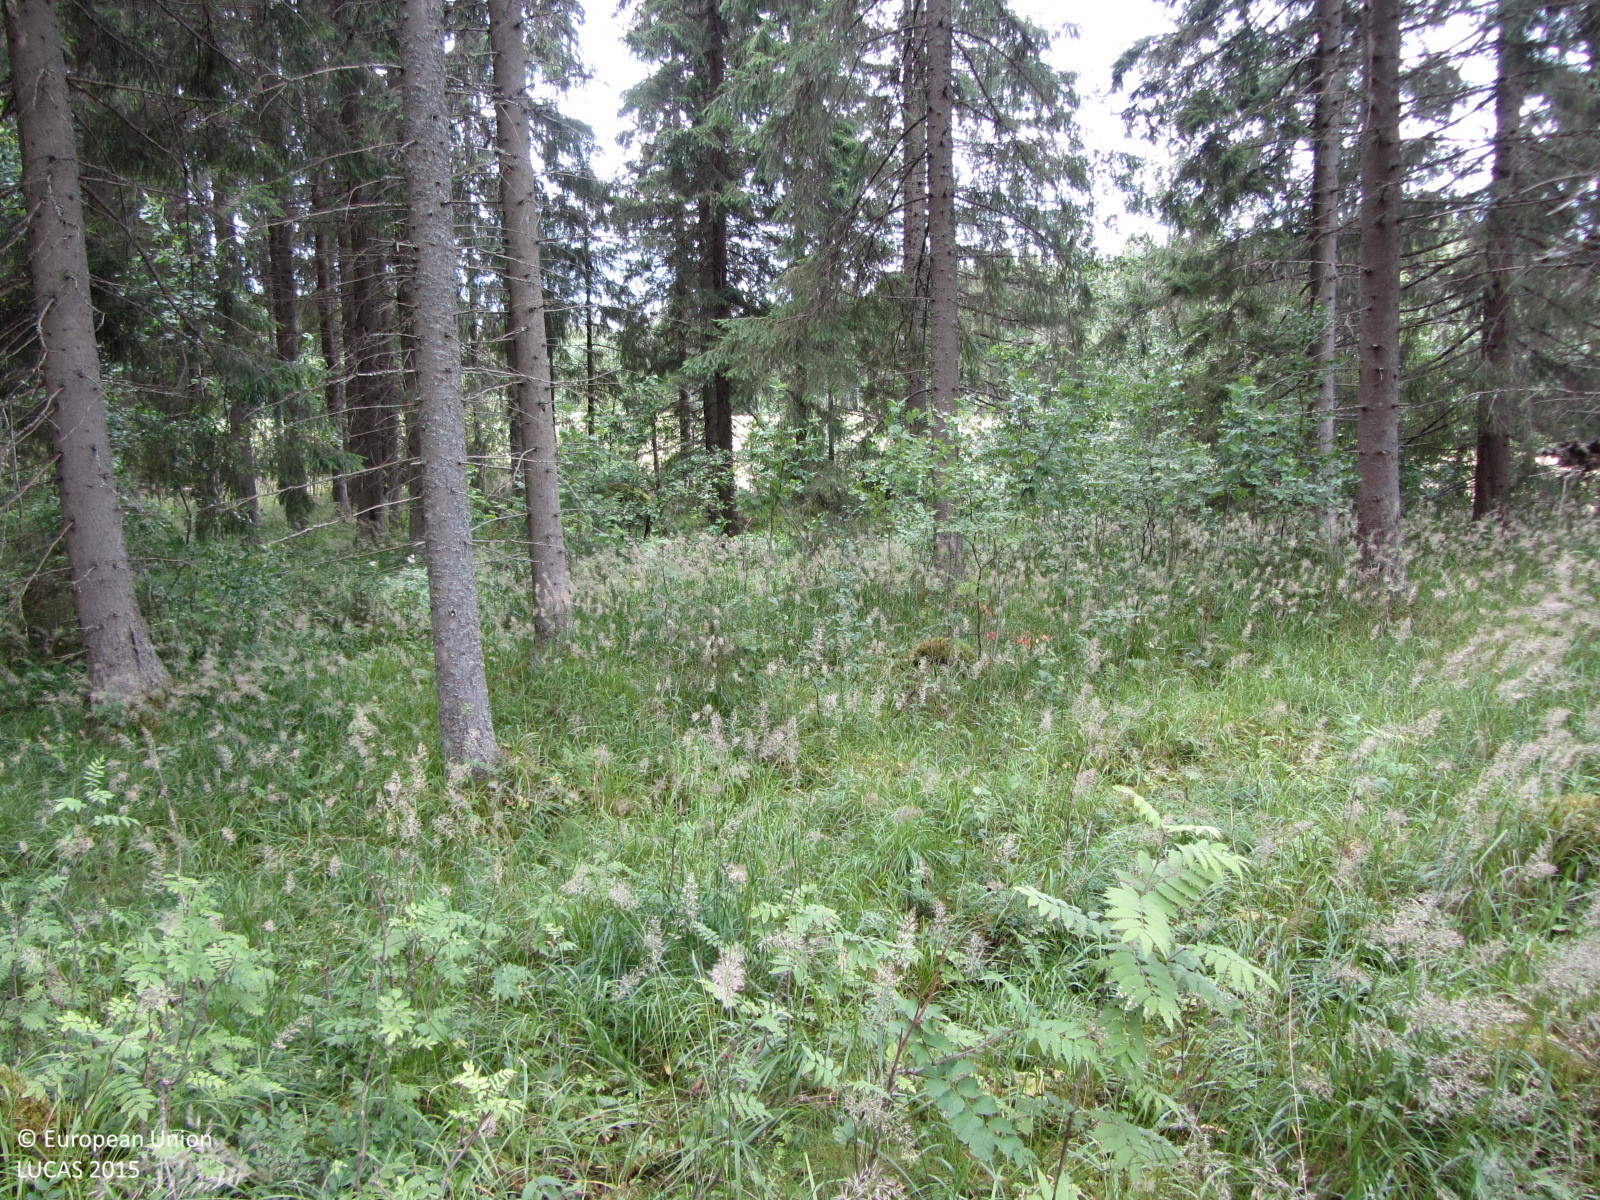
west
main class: Woodland
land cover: Spruce dominated coniferous woodland
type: boreal forest
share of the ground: > 75 %
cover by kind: coniferous forest trees 80 %, herbaceous plants 15 %, broadleaved forest trees 5 %
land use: Forestry
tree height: > 5 m
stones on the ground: 10 - 25 %
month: August
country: FI
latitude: 60.6932
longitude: 24.6686
